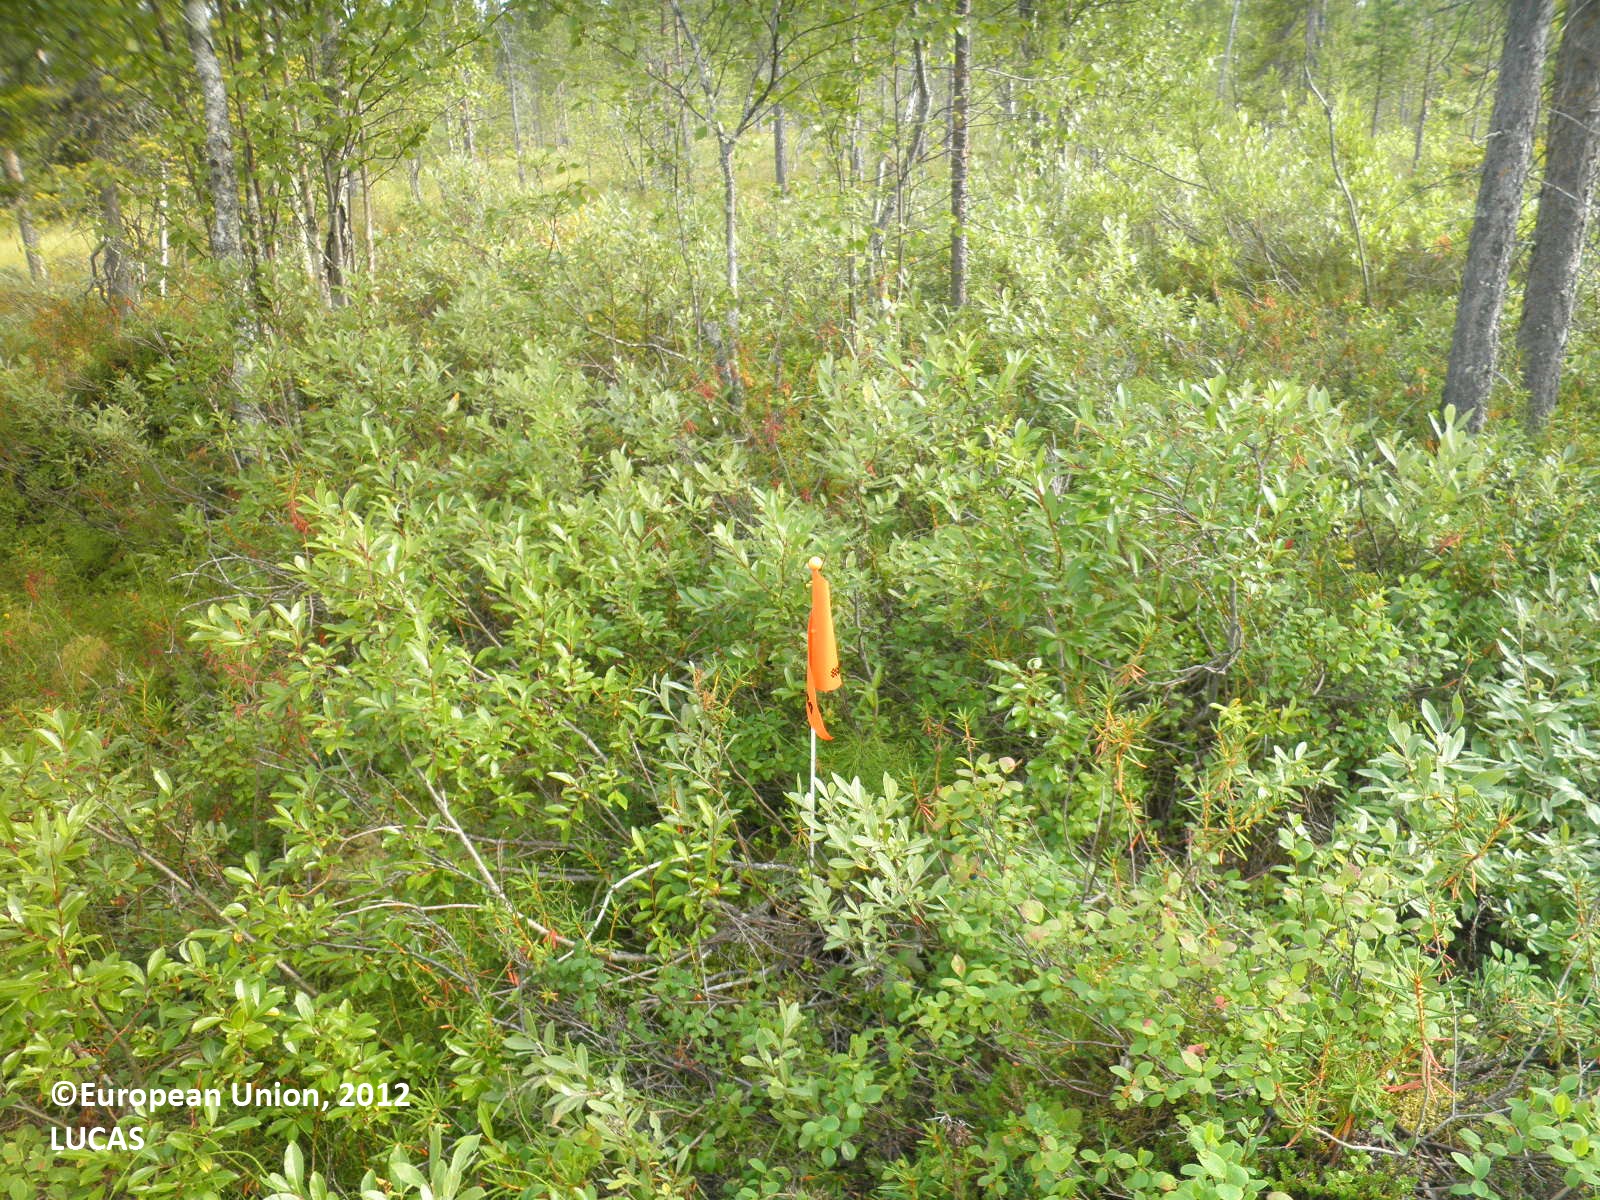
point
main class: Woodland
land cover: Pine dominated mixed woodland
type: boreal forest
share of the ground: 25 - 50 %
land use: Forestry
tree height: > 5 m
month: August
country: FI
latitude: 67.5038
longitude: 27.0653
